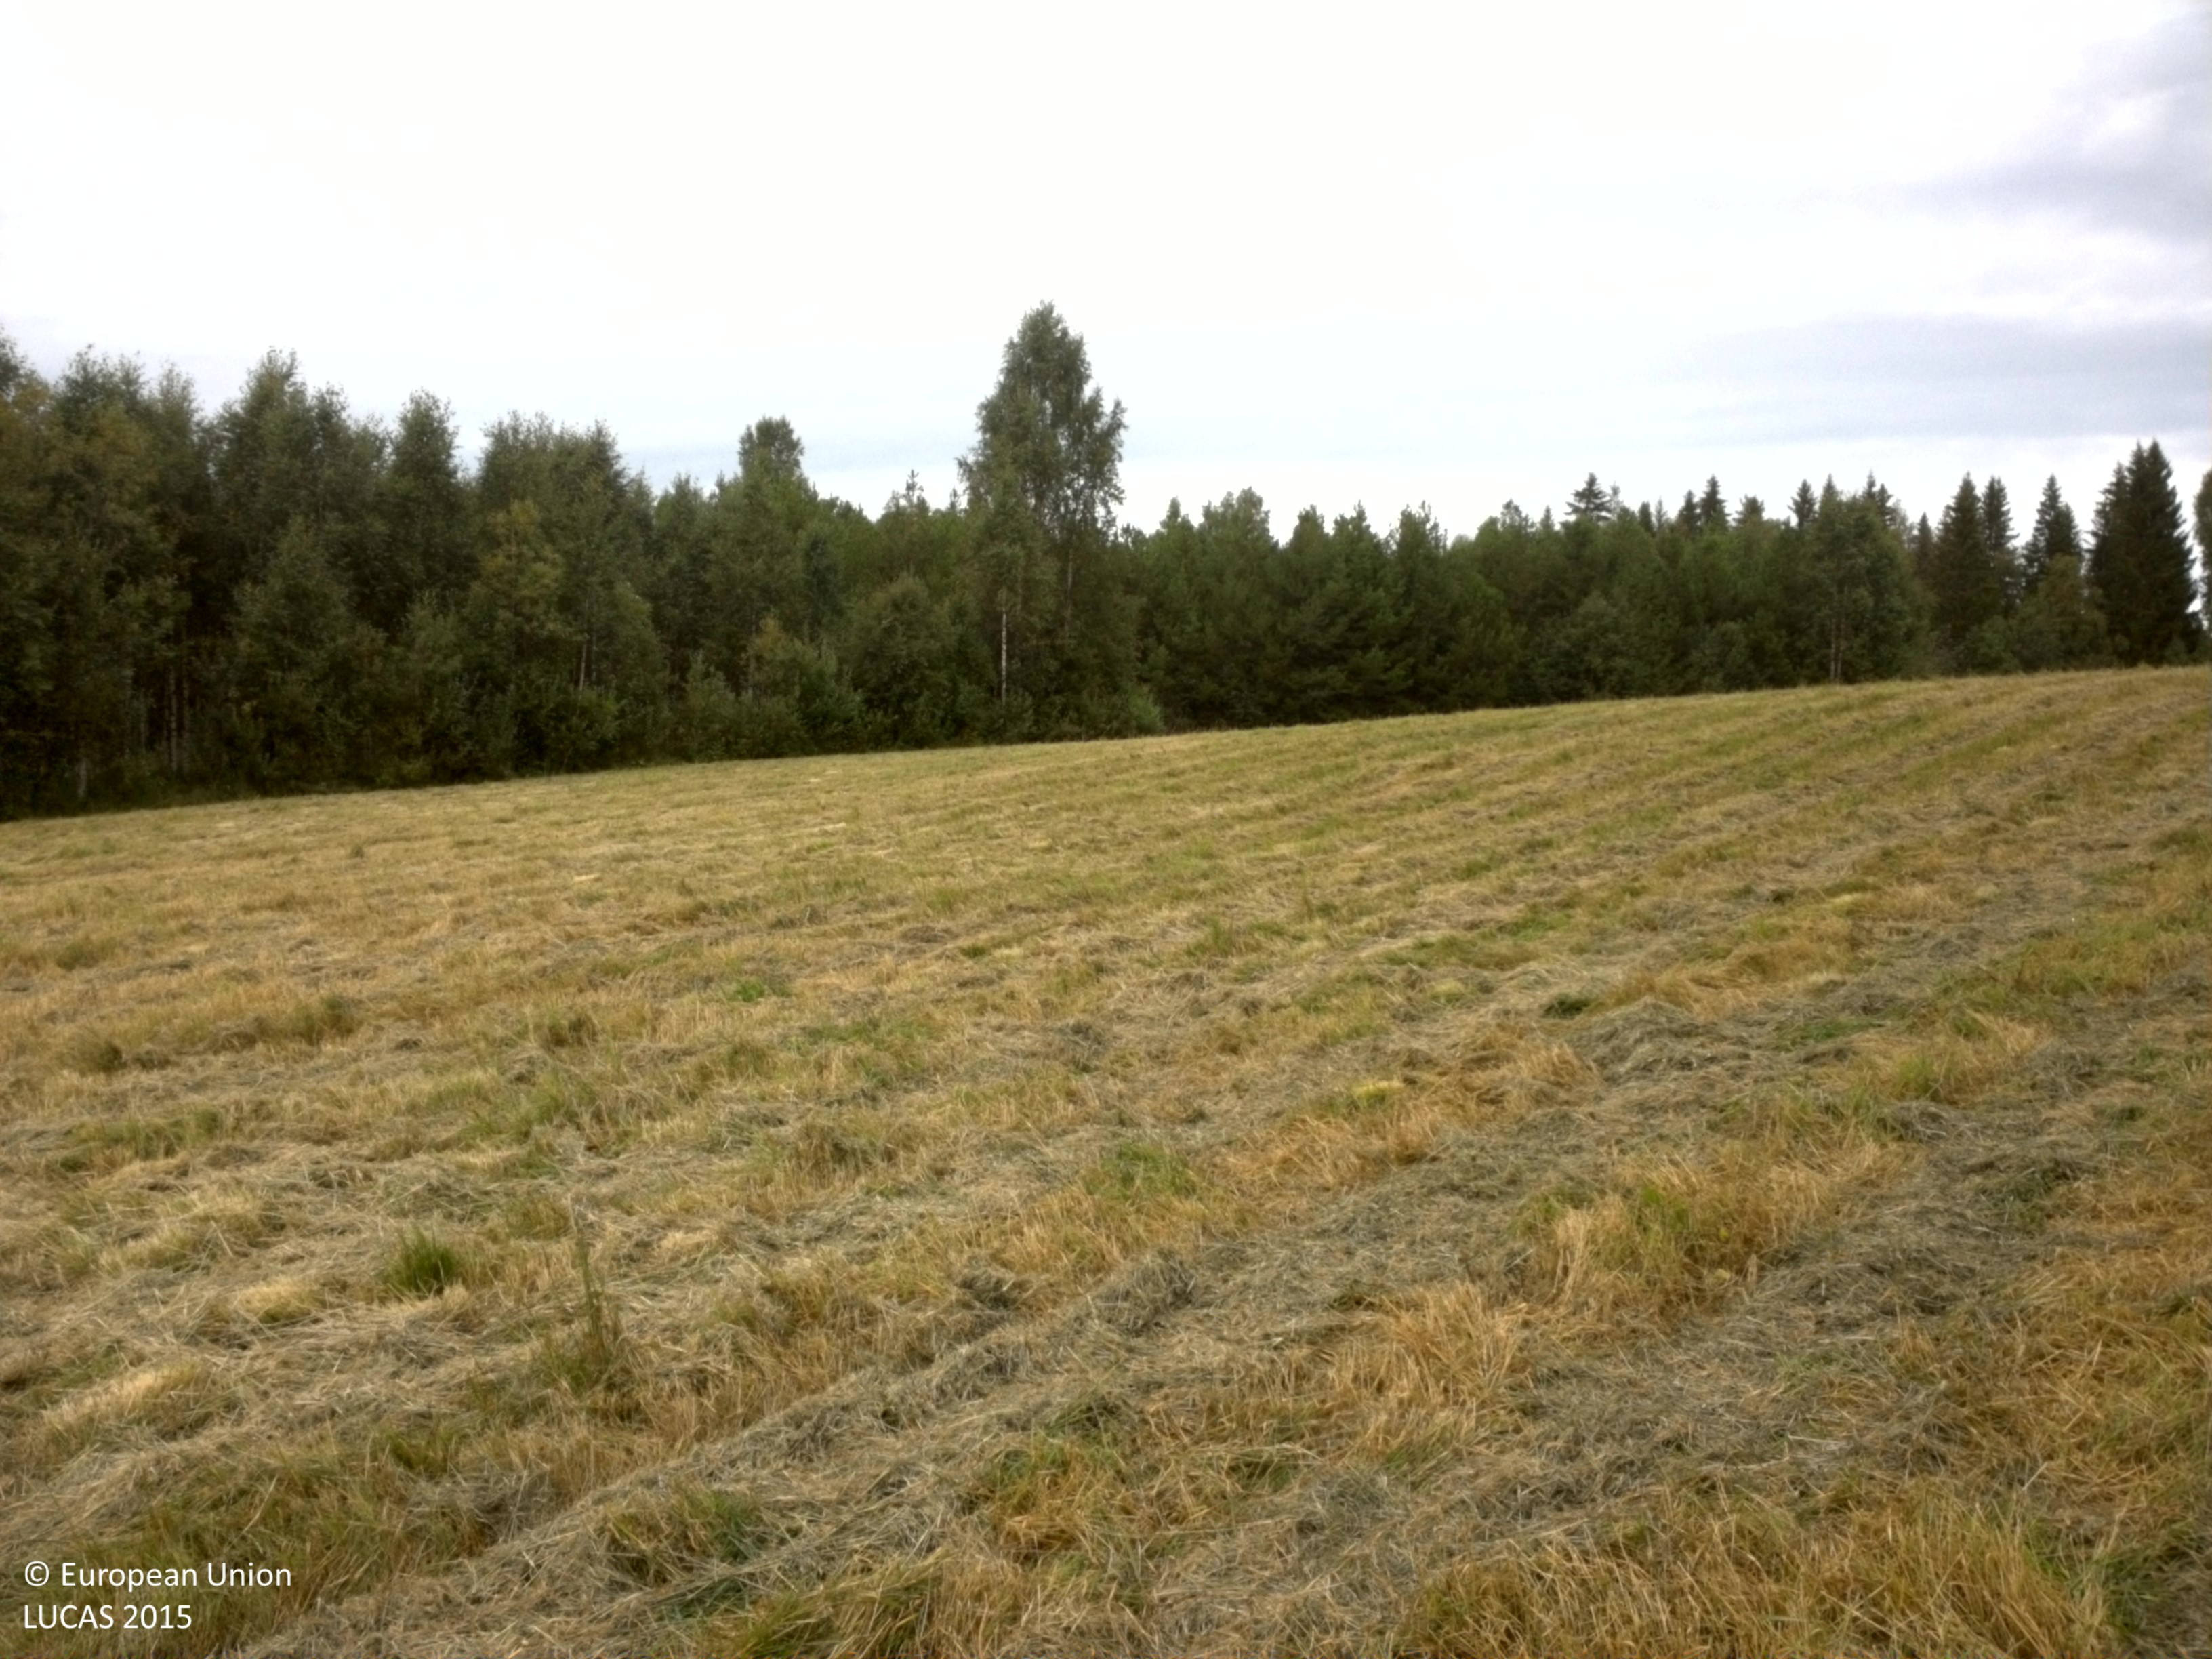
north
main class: Grassland
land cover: Grassland without tree/shrub cover
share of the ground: > 75 %
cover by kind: herbaceous plants 100 %
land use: Agriculture (excluding fallow land and kitchen gardens)
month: August
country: SE
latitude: 64.6019
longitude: 20.6973
